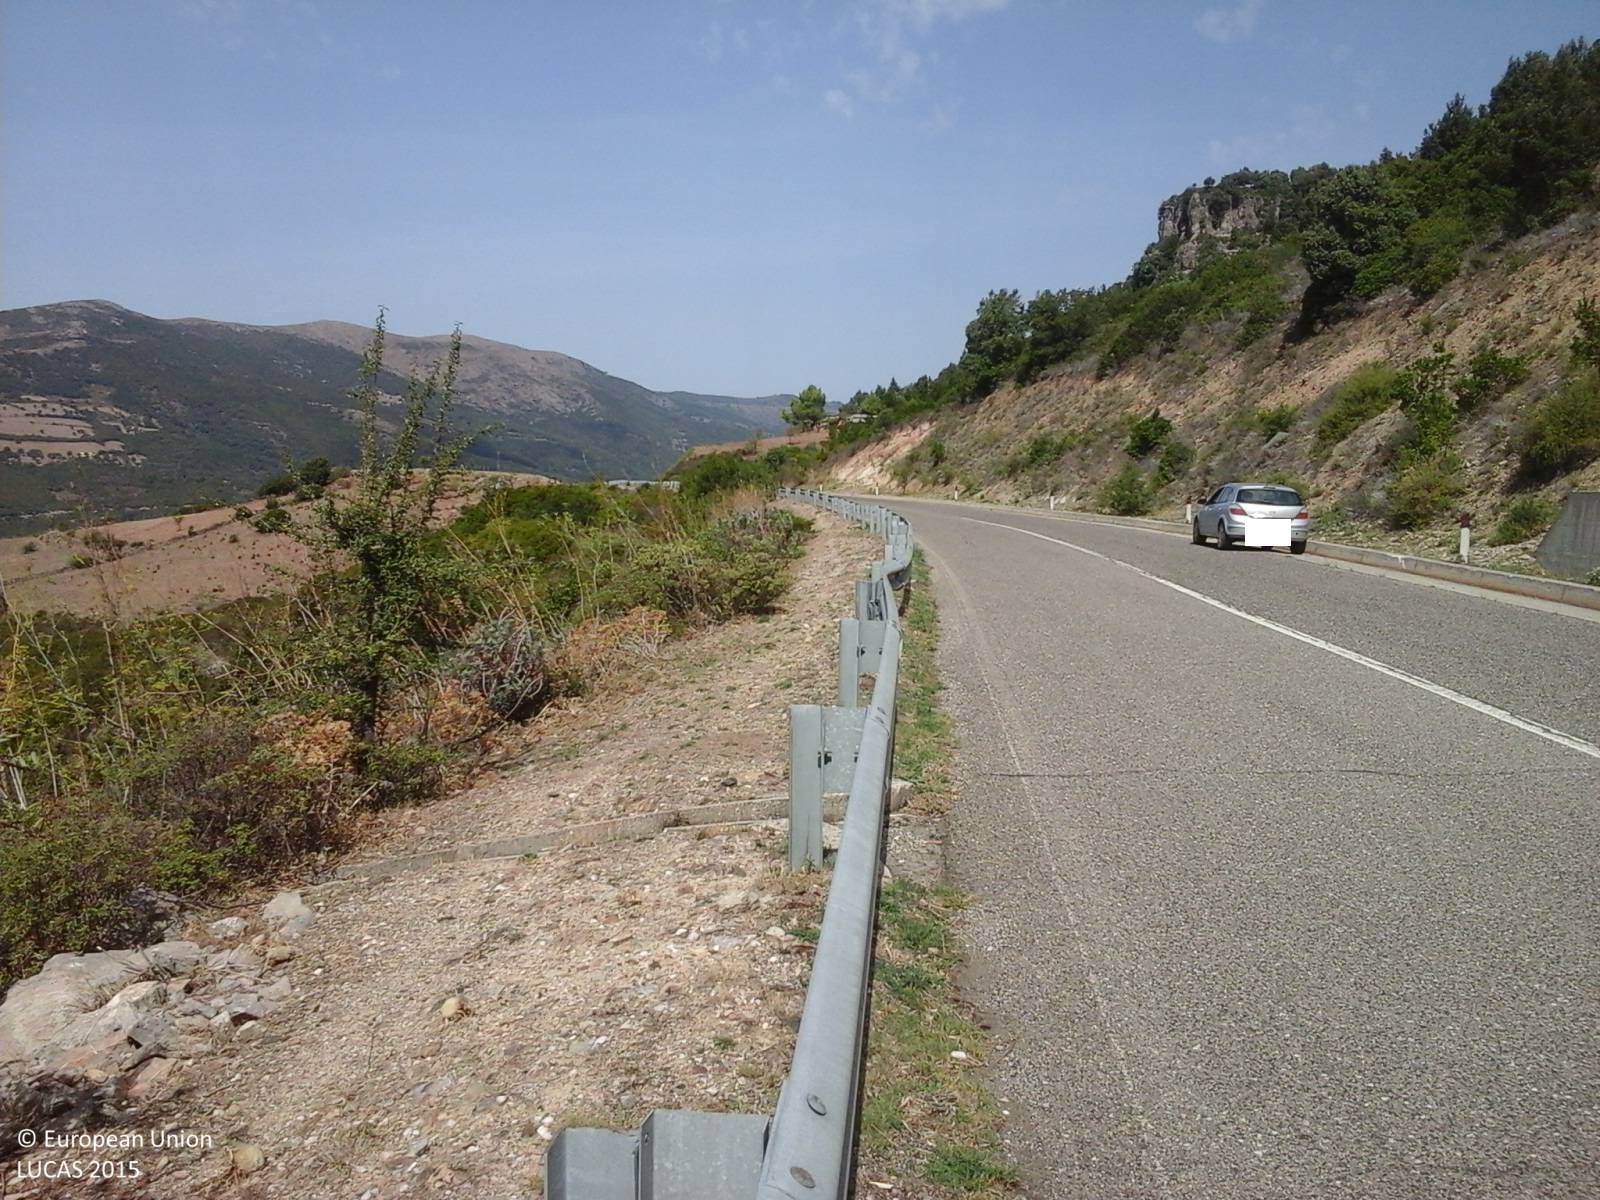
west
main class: Woodland
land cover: Broadleaved woodland
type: broadleaved evergreen forest
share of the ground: > 75 %
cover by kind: broadleaved forest trees 80 %, shrubs 15 %, unconsolidated bare surface 5 %
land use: Semi-natural and natural areas not in use
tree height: > 5 m
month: September
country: IT
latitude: 39.8657
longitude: 9.1979
